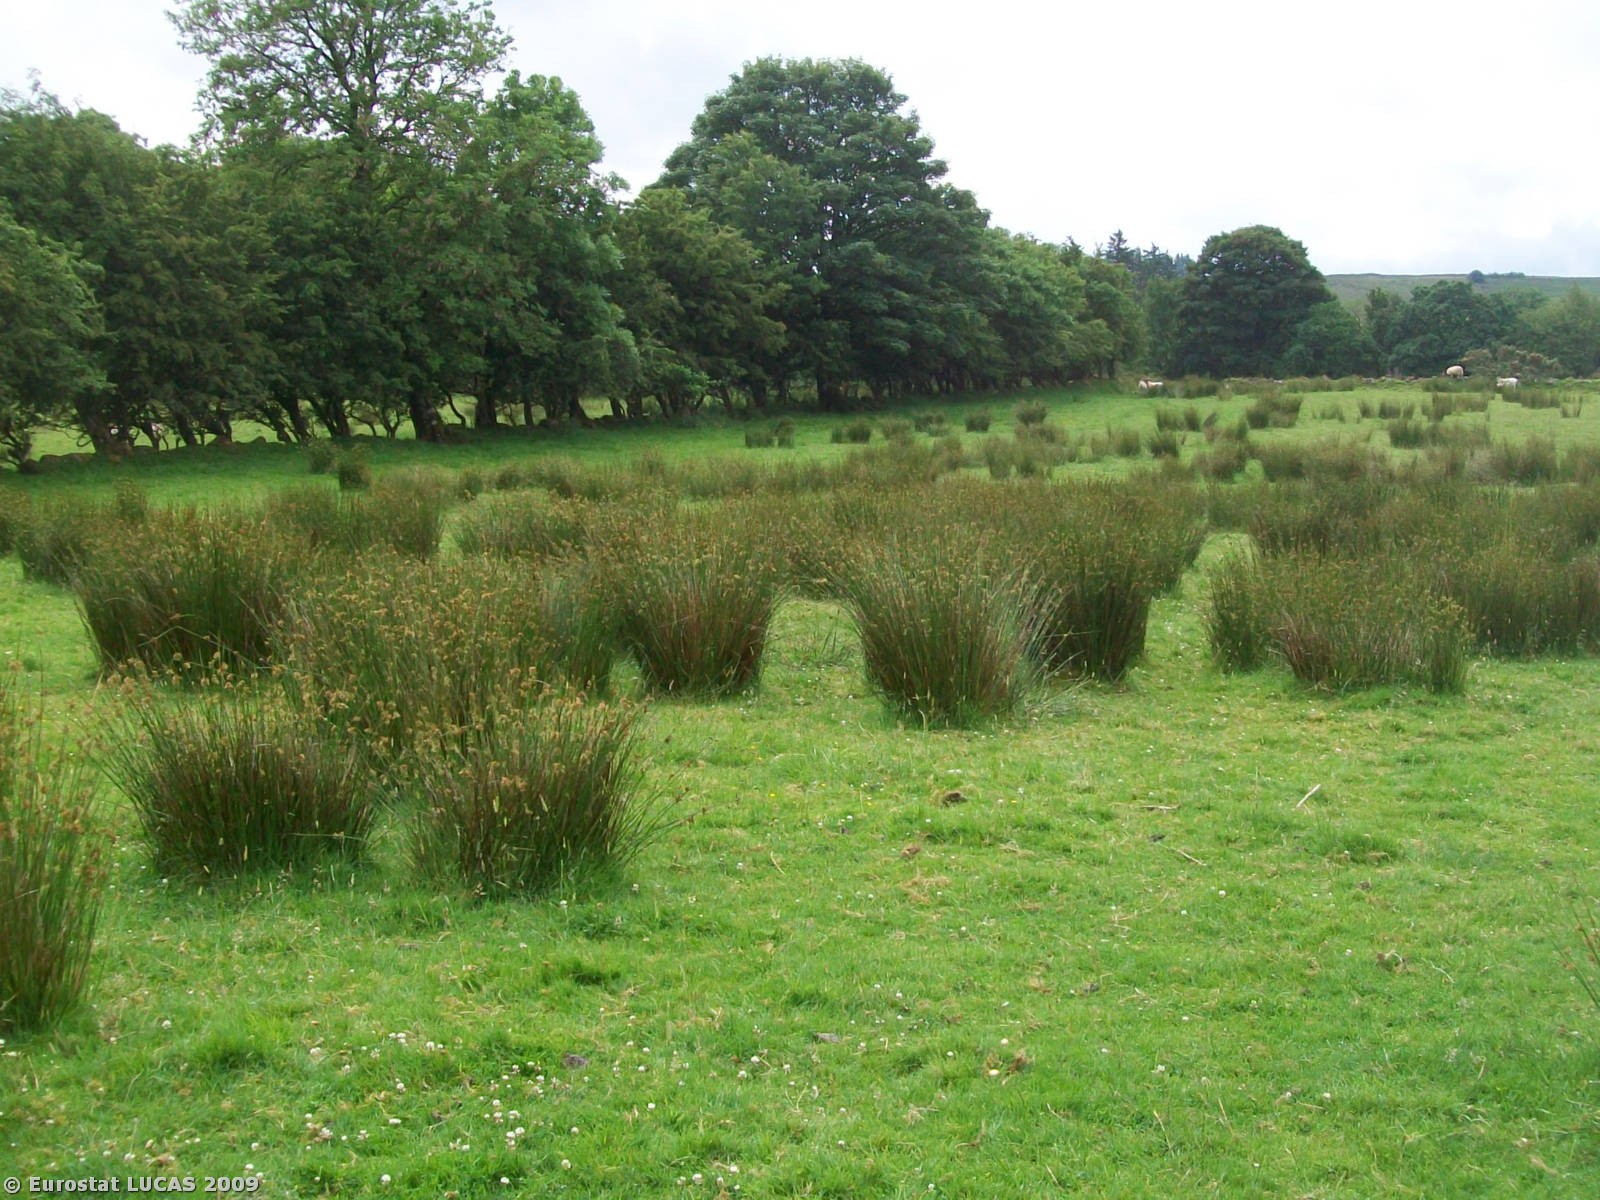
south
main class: Grassland
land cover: Grassland without tree/shrub cover
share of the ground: > 75 %
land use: Agriculture (excluding fallow land and kitchen gardens)
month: July
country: GB
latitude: 54.9407
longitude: -6.7873
